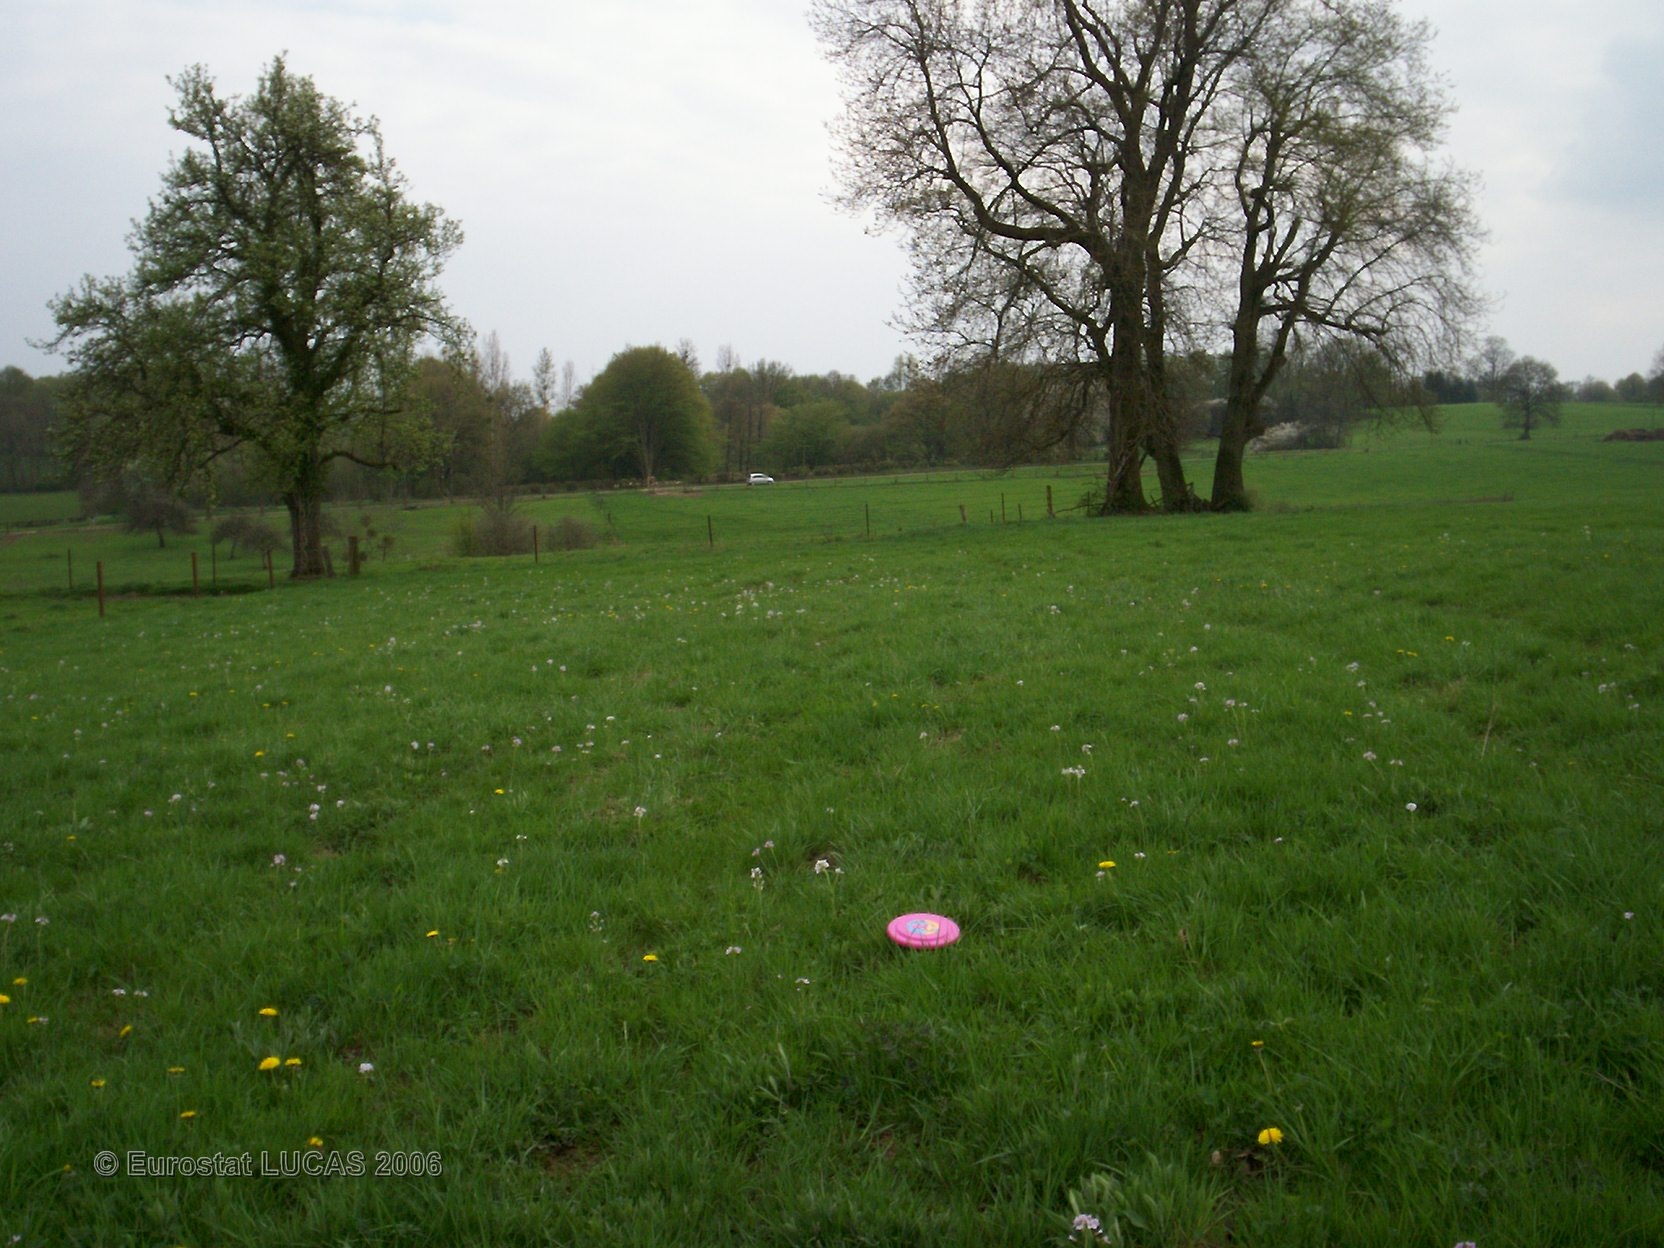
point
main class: Grassland
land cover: Grassland without tree/shrub cover
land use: Agriculture (excluding fallow land and kitchen gardens)
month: April
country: FR
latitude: 49.7045
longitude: 4.4079
